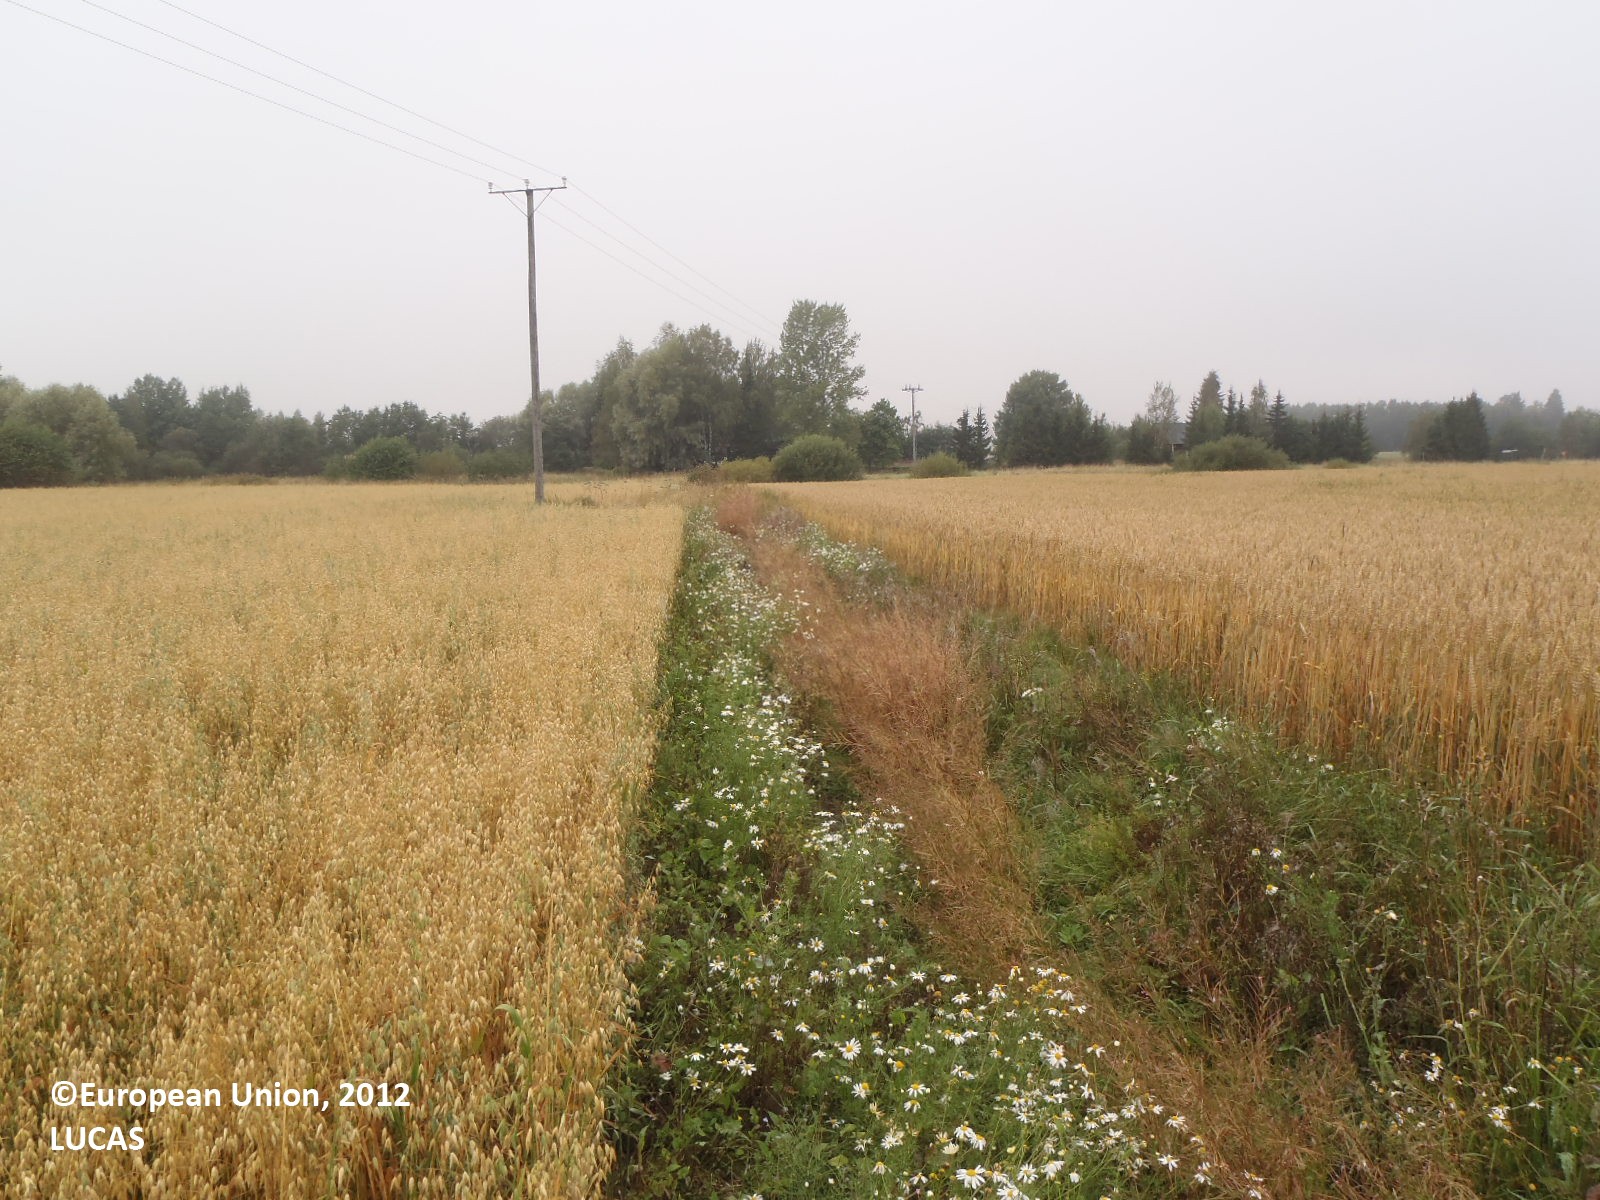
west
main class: Cropland
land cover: Oats
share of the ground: > 75 %
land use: Agriculture (excluding fallow land and kitchen gardens)
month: August
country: FI
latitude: 60.6540
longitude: 22.6010
